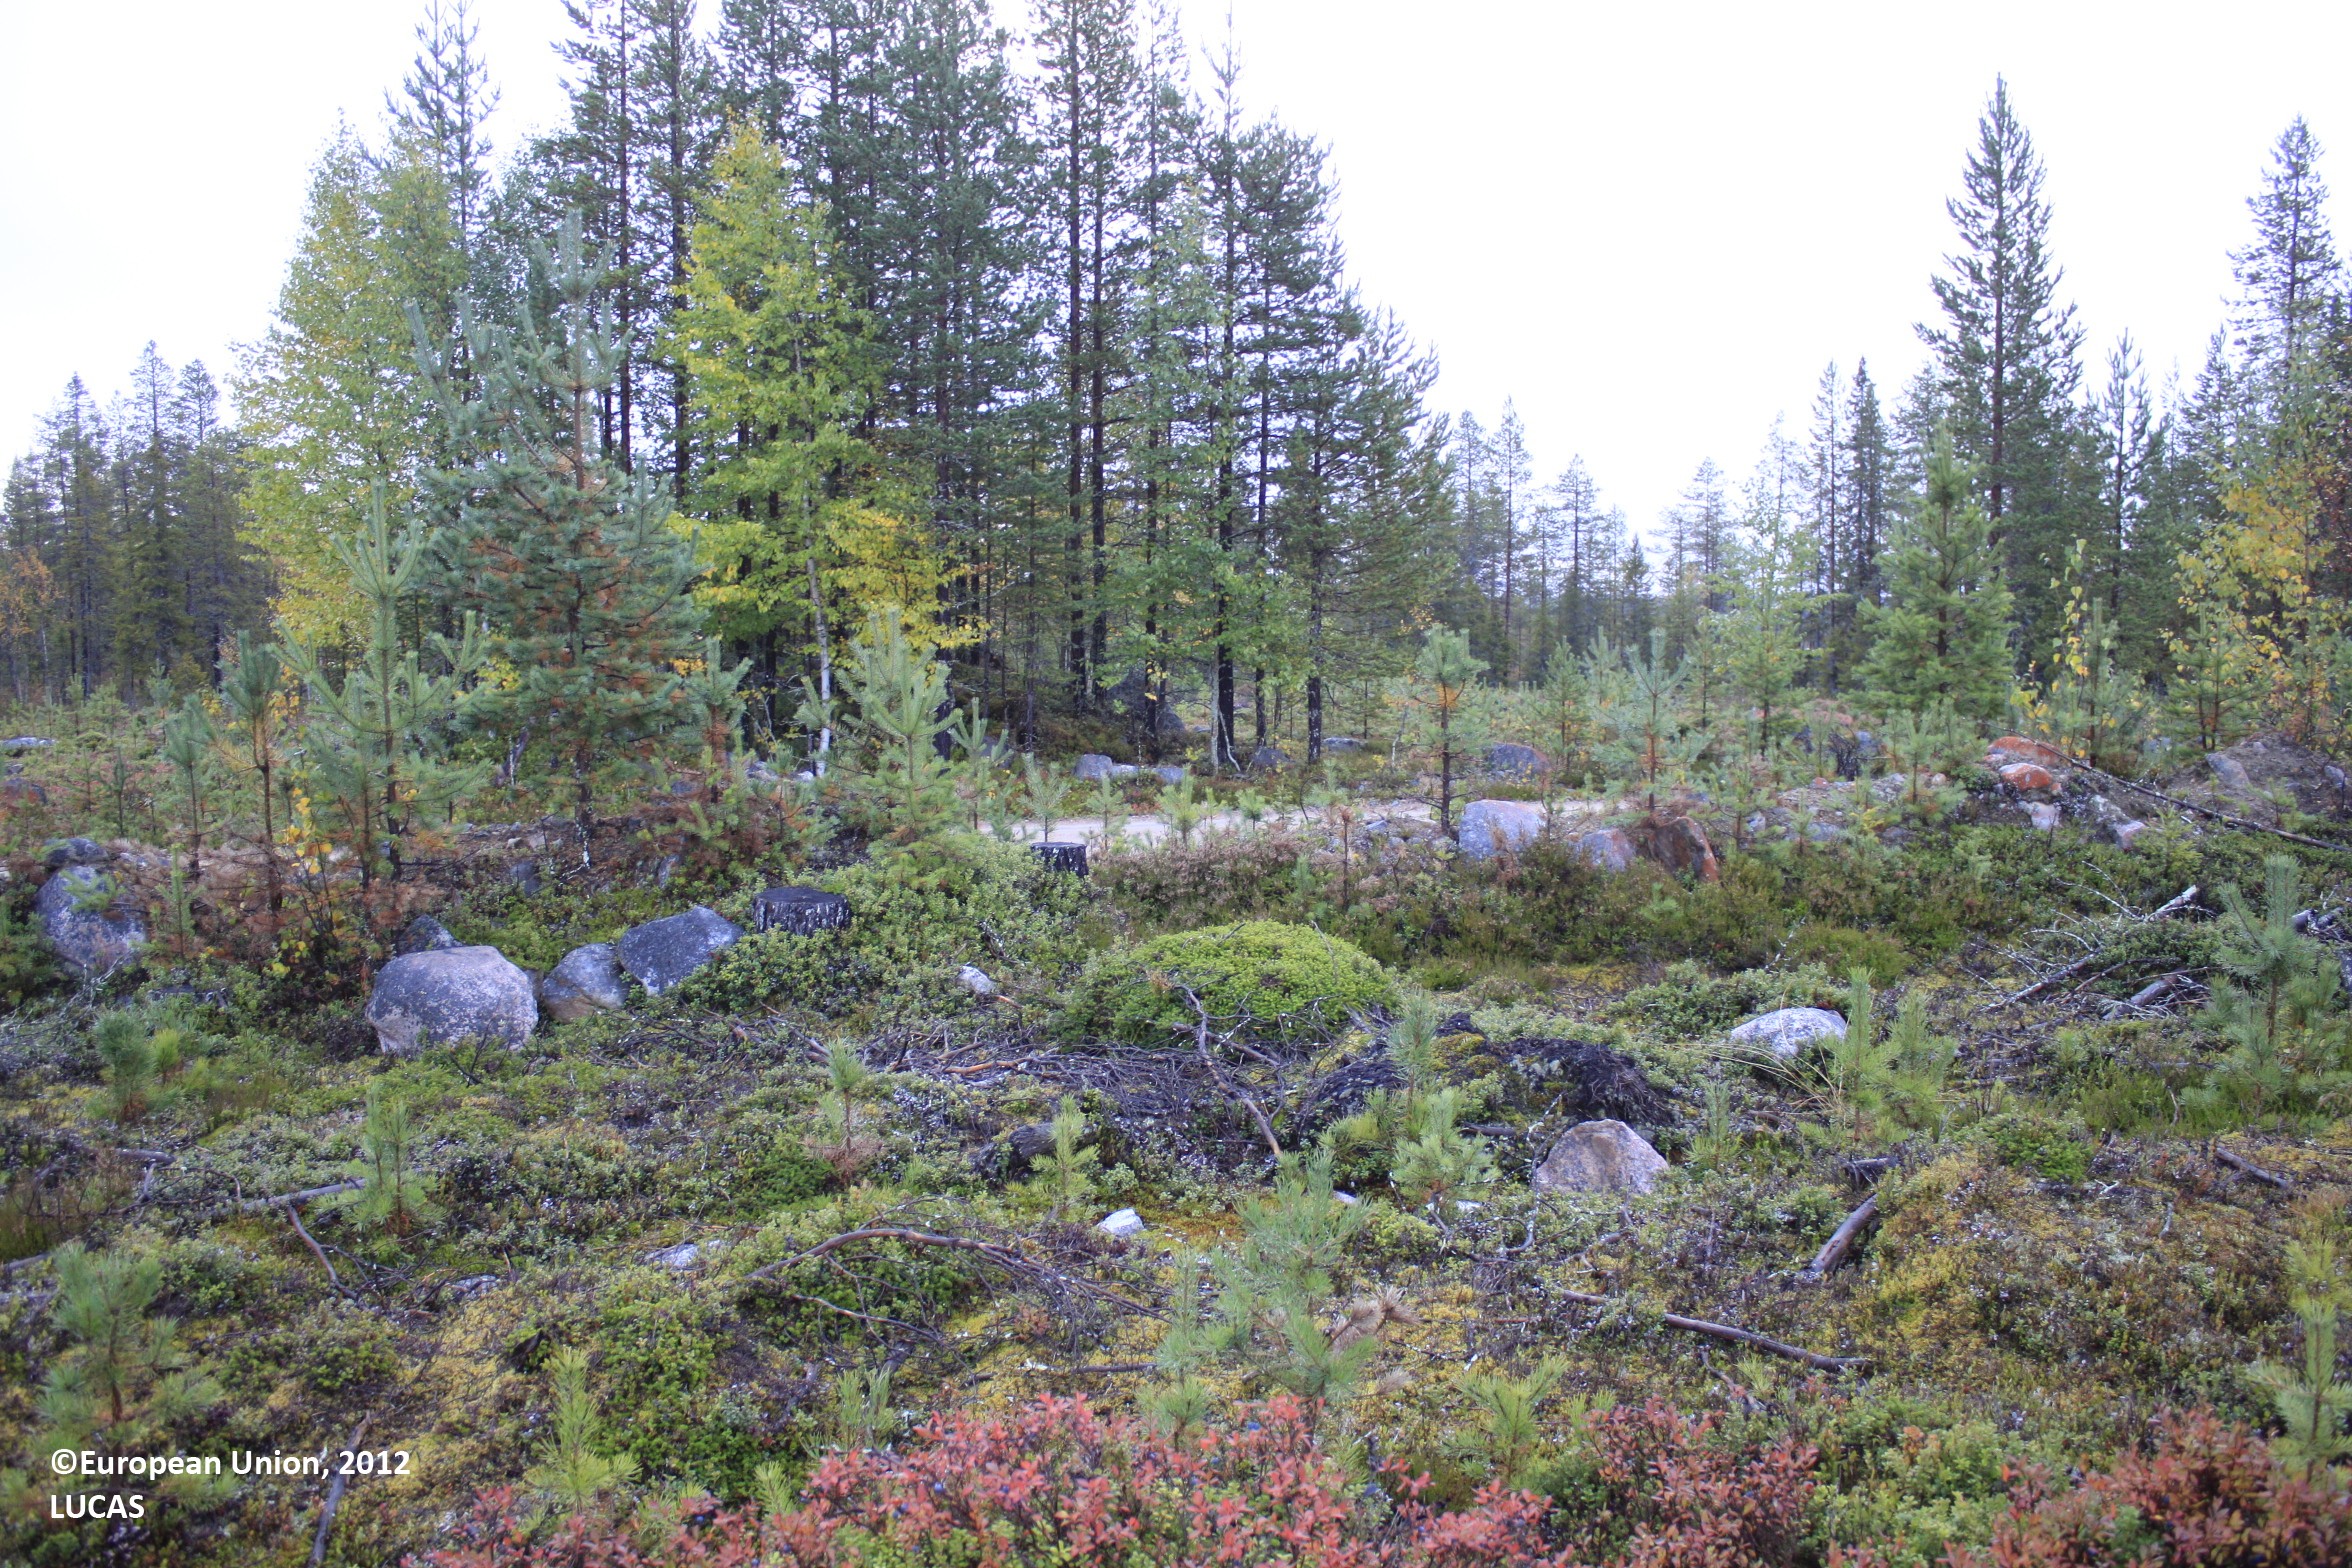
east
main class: Woodland
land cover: Pine dominated coniferous woodland
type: boreal forest
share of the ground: 10 - 25 %
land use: Forestry
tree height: < 5 m
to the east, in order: Pine dominated coniferous woodland; Ditches and canals; Tracks; Pine dominated mixed woodland; Pine dominated coniferous woodland; Pine dominated mixed woodland
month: September
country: FI
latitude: 66.0205
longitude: 26.7943
